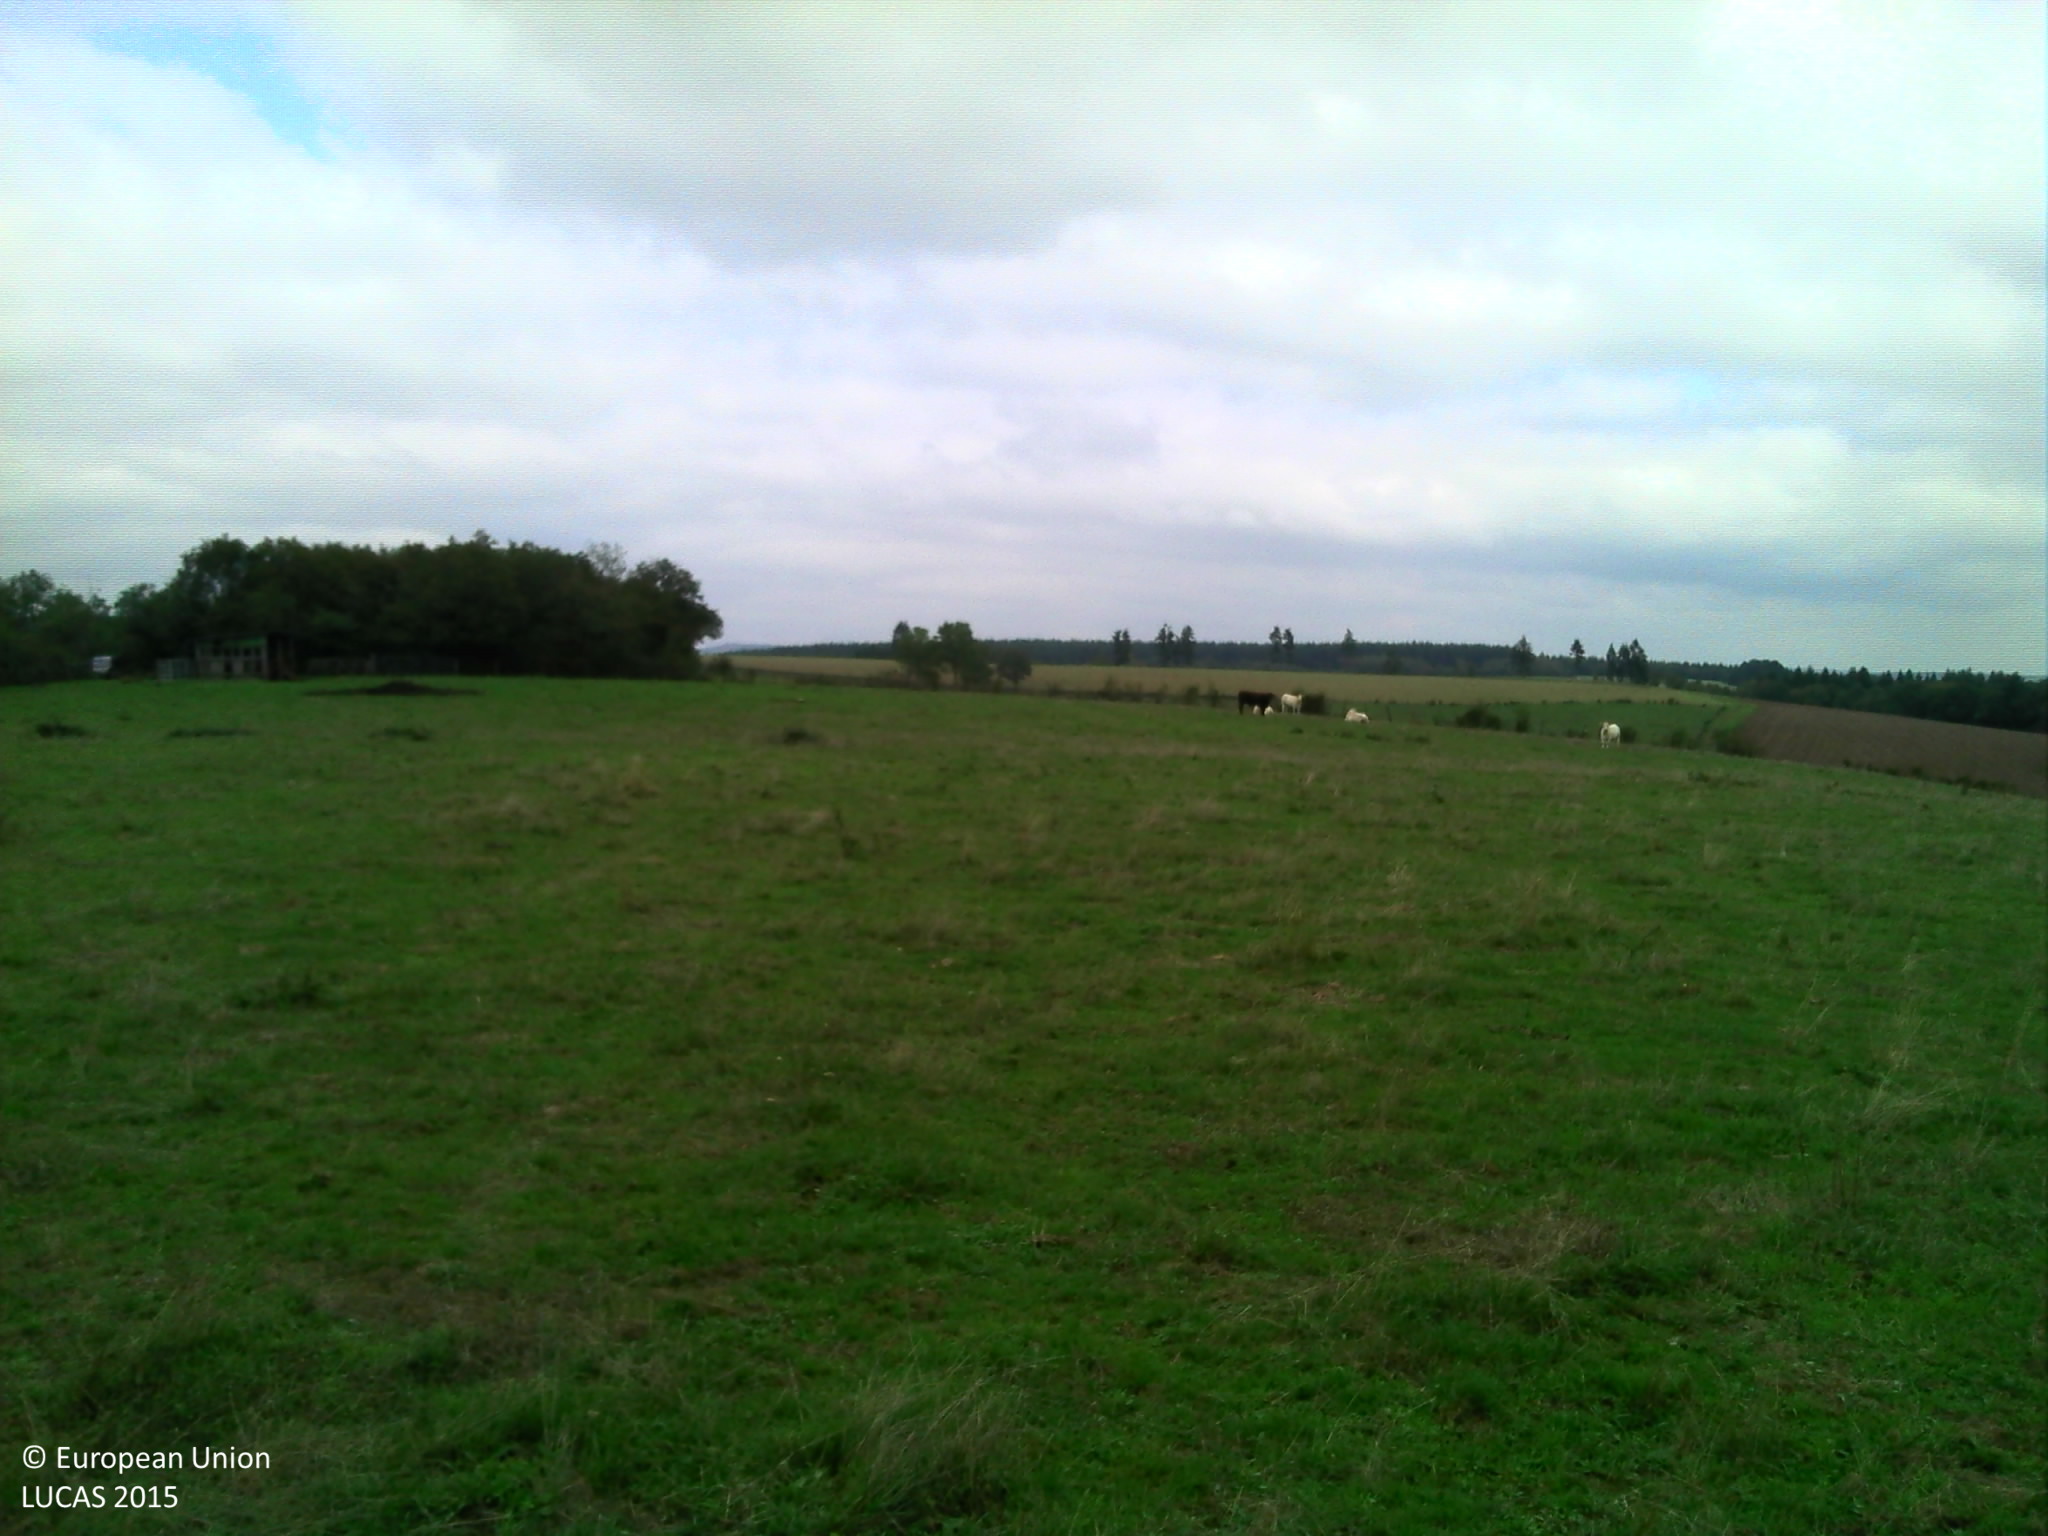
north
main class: Grassland
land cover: Grassland without tree/shrub cover
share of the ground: > 75 %
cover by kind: herbaceous plants 100 %
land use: Agriculture (excluding fallow land and kitchen gardens)
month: September
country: FR
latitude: 47.0683
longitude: 4.3507
